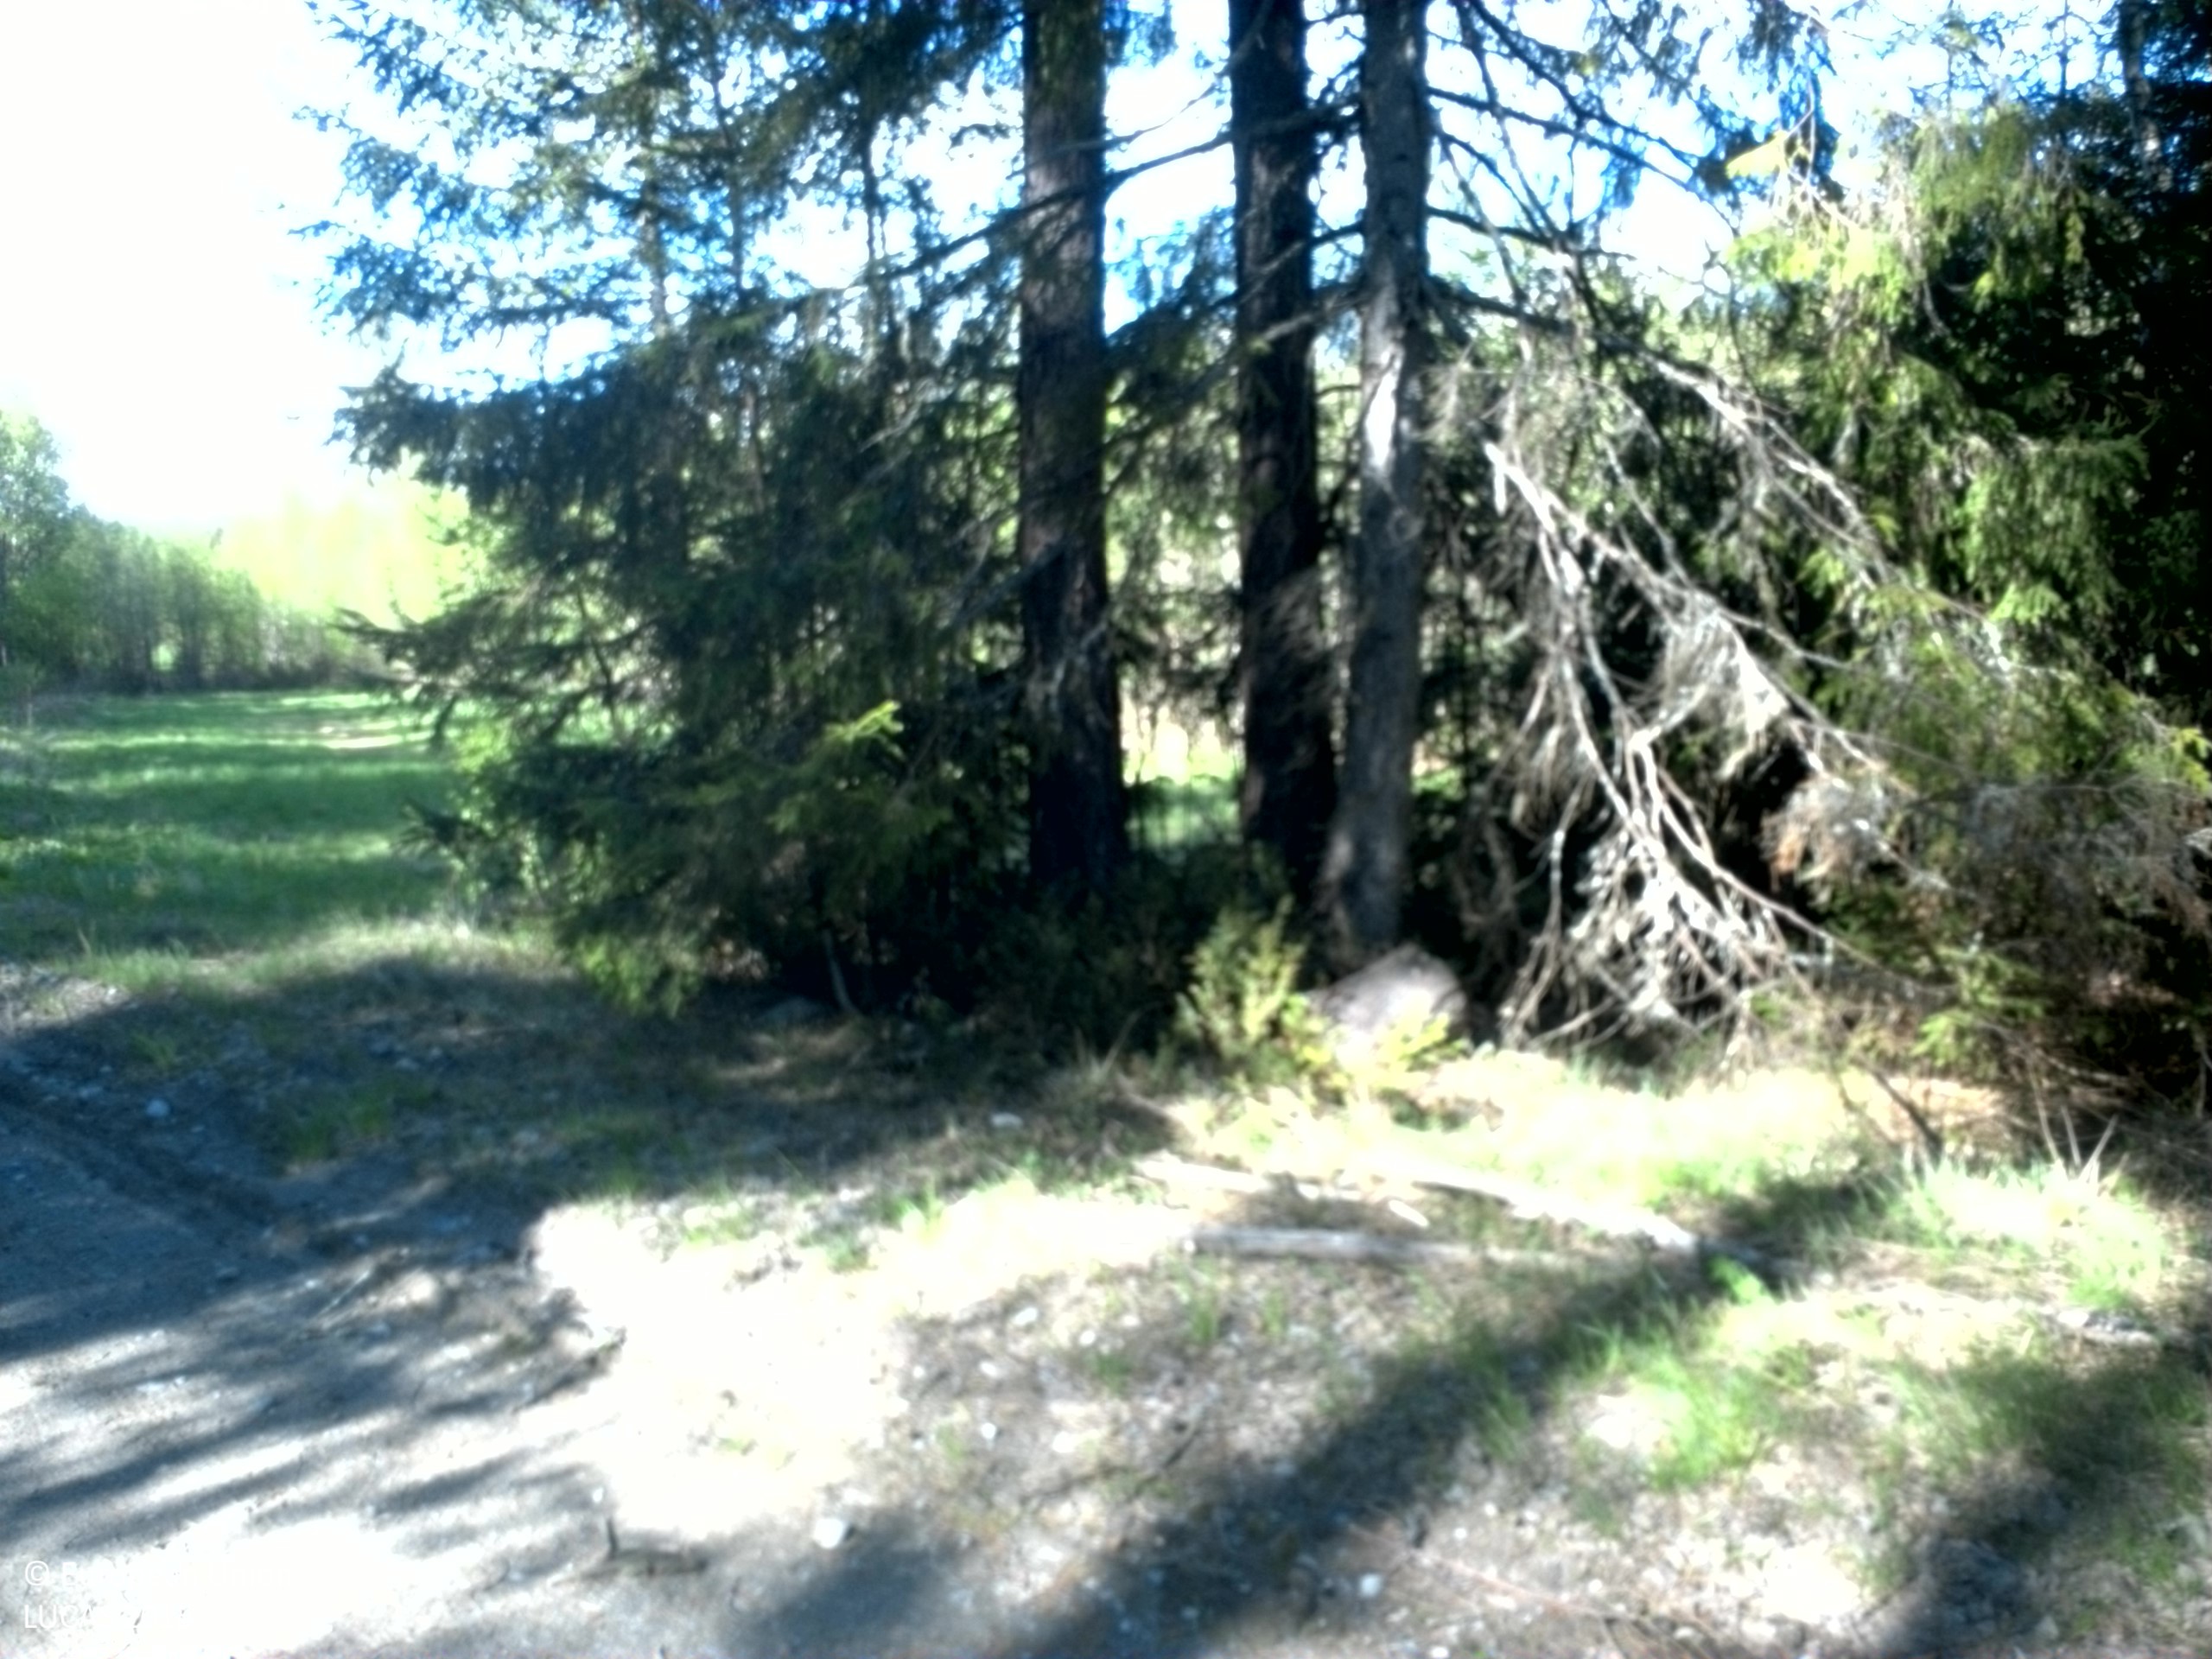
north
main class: Woodland
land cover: Pine dominated coniferous woodland
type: boreal forest
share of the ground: 50 - 75 %
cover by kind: coniferous forest trees 60 %, shrubs 20 %, lichens and mosses 10 %, consolidated bare surface 10 %
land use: Semi-natural and natural areas not in use
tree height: > 5 m
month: May
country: SE
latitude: 63.0414
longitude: 17.8664
